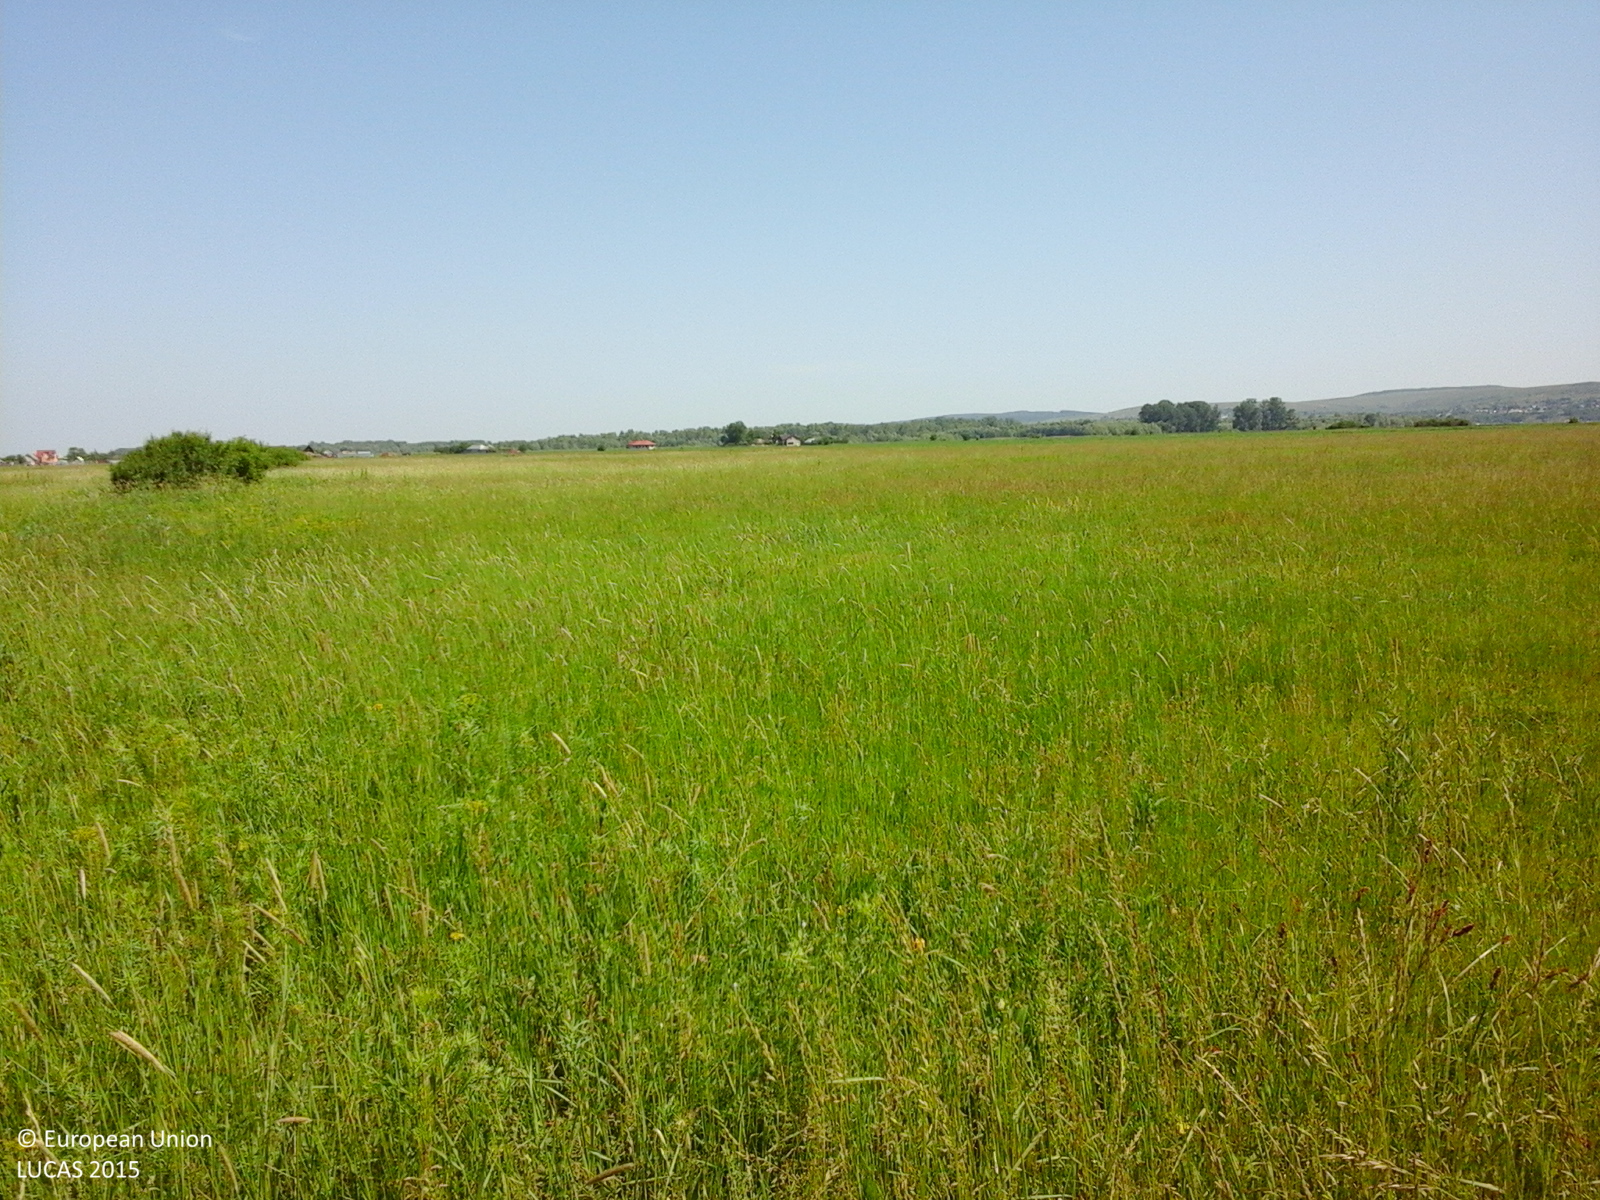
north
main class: Grassland
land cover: Grassland without tree/shrub cover
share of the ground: > 75 %
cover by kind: herbaceous plants 100 %
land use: Agriculture (excluding fallow land and kitchen gardens)
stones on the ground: < 10 %
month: June
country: RO
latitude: 46.6215
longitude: 26.9551
